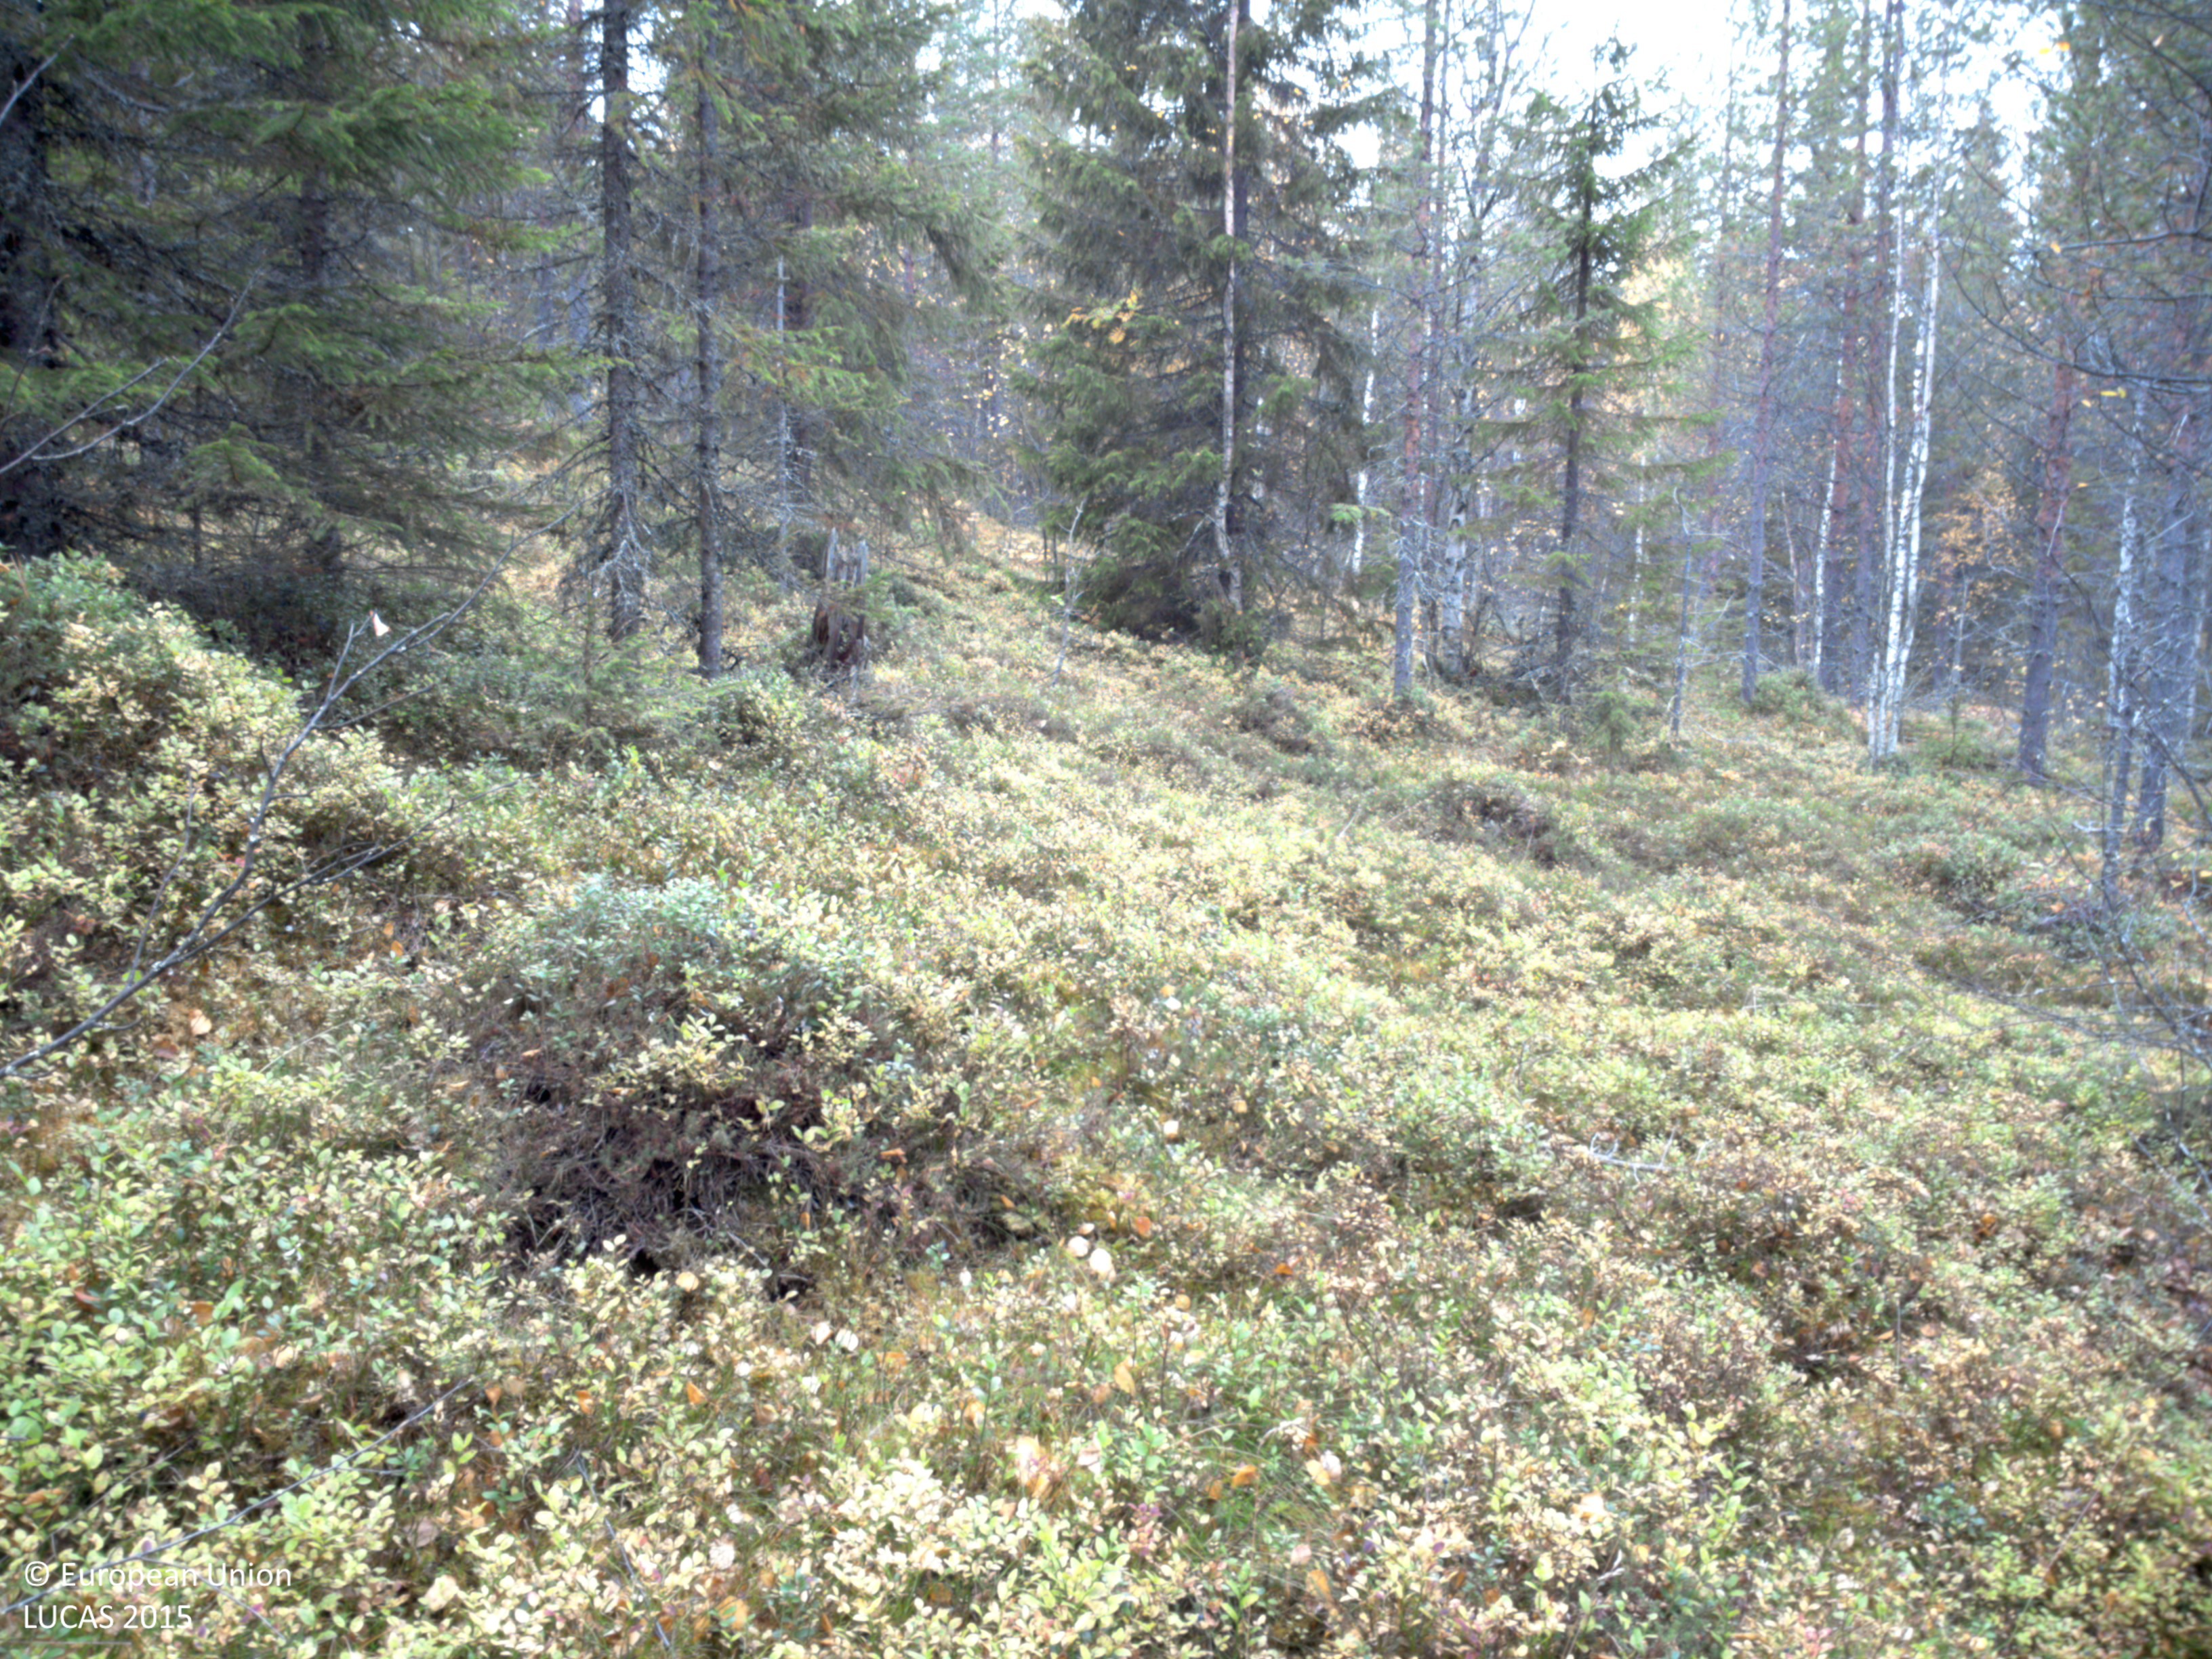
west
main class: Woodland
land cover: Other coniferous woodland
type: boreal forest
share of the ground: > 75 %
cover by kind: coniferous forest trees 75 %, shrubs 15 %, herbaceous plants 5 %, lichens and mosses 5 %
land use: Forestry
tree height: > 5 m
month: October
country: SE
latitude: 65.0125
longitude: 18.3870
